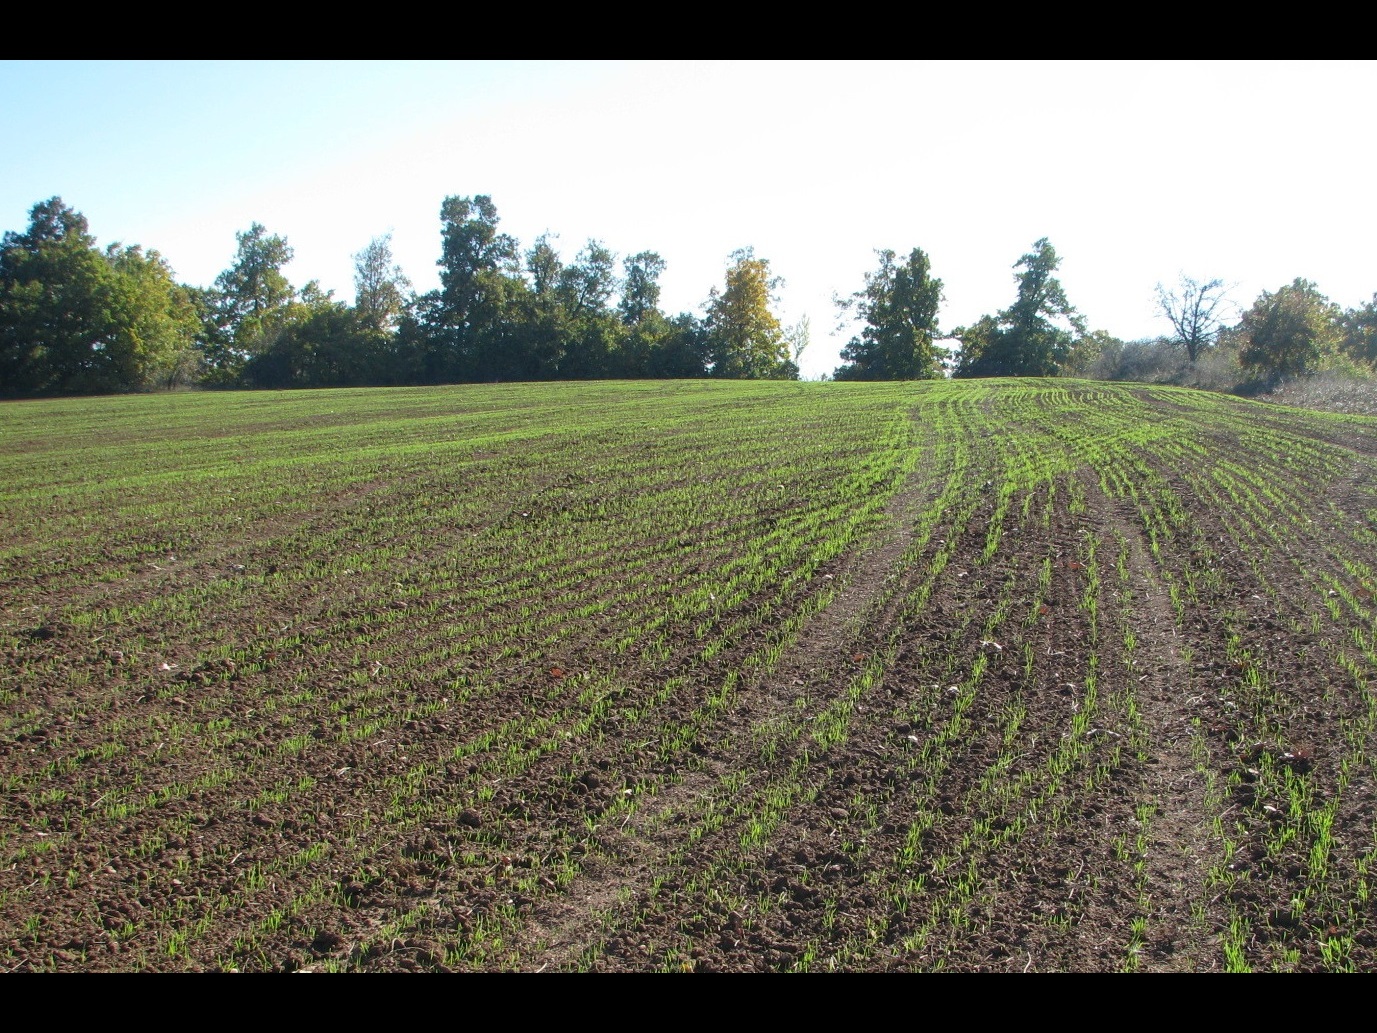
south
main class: Cropland
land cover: Common wheat
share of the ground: 10 - 25 %
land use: Agriculture (excluding fallow land and kitchen gardens)
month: November
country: BG
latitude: 42.0363
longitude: 26.8738
